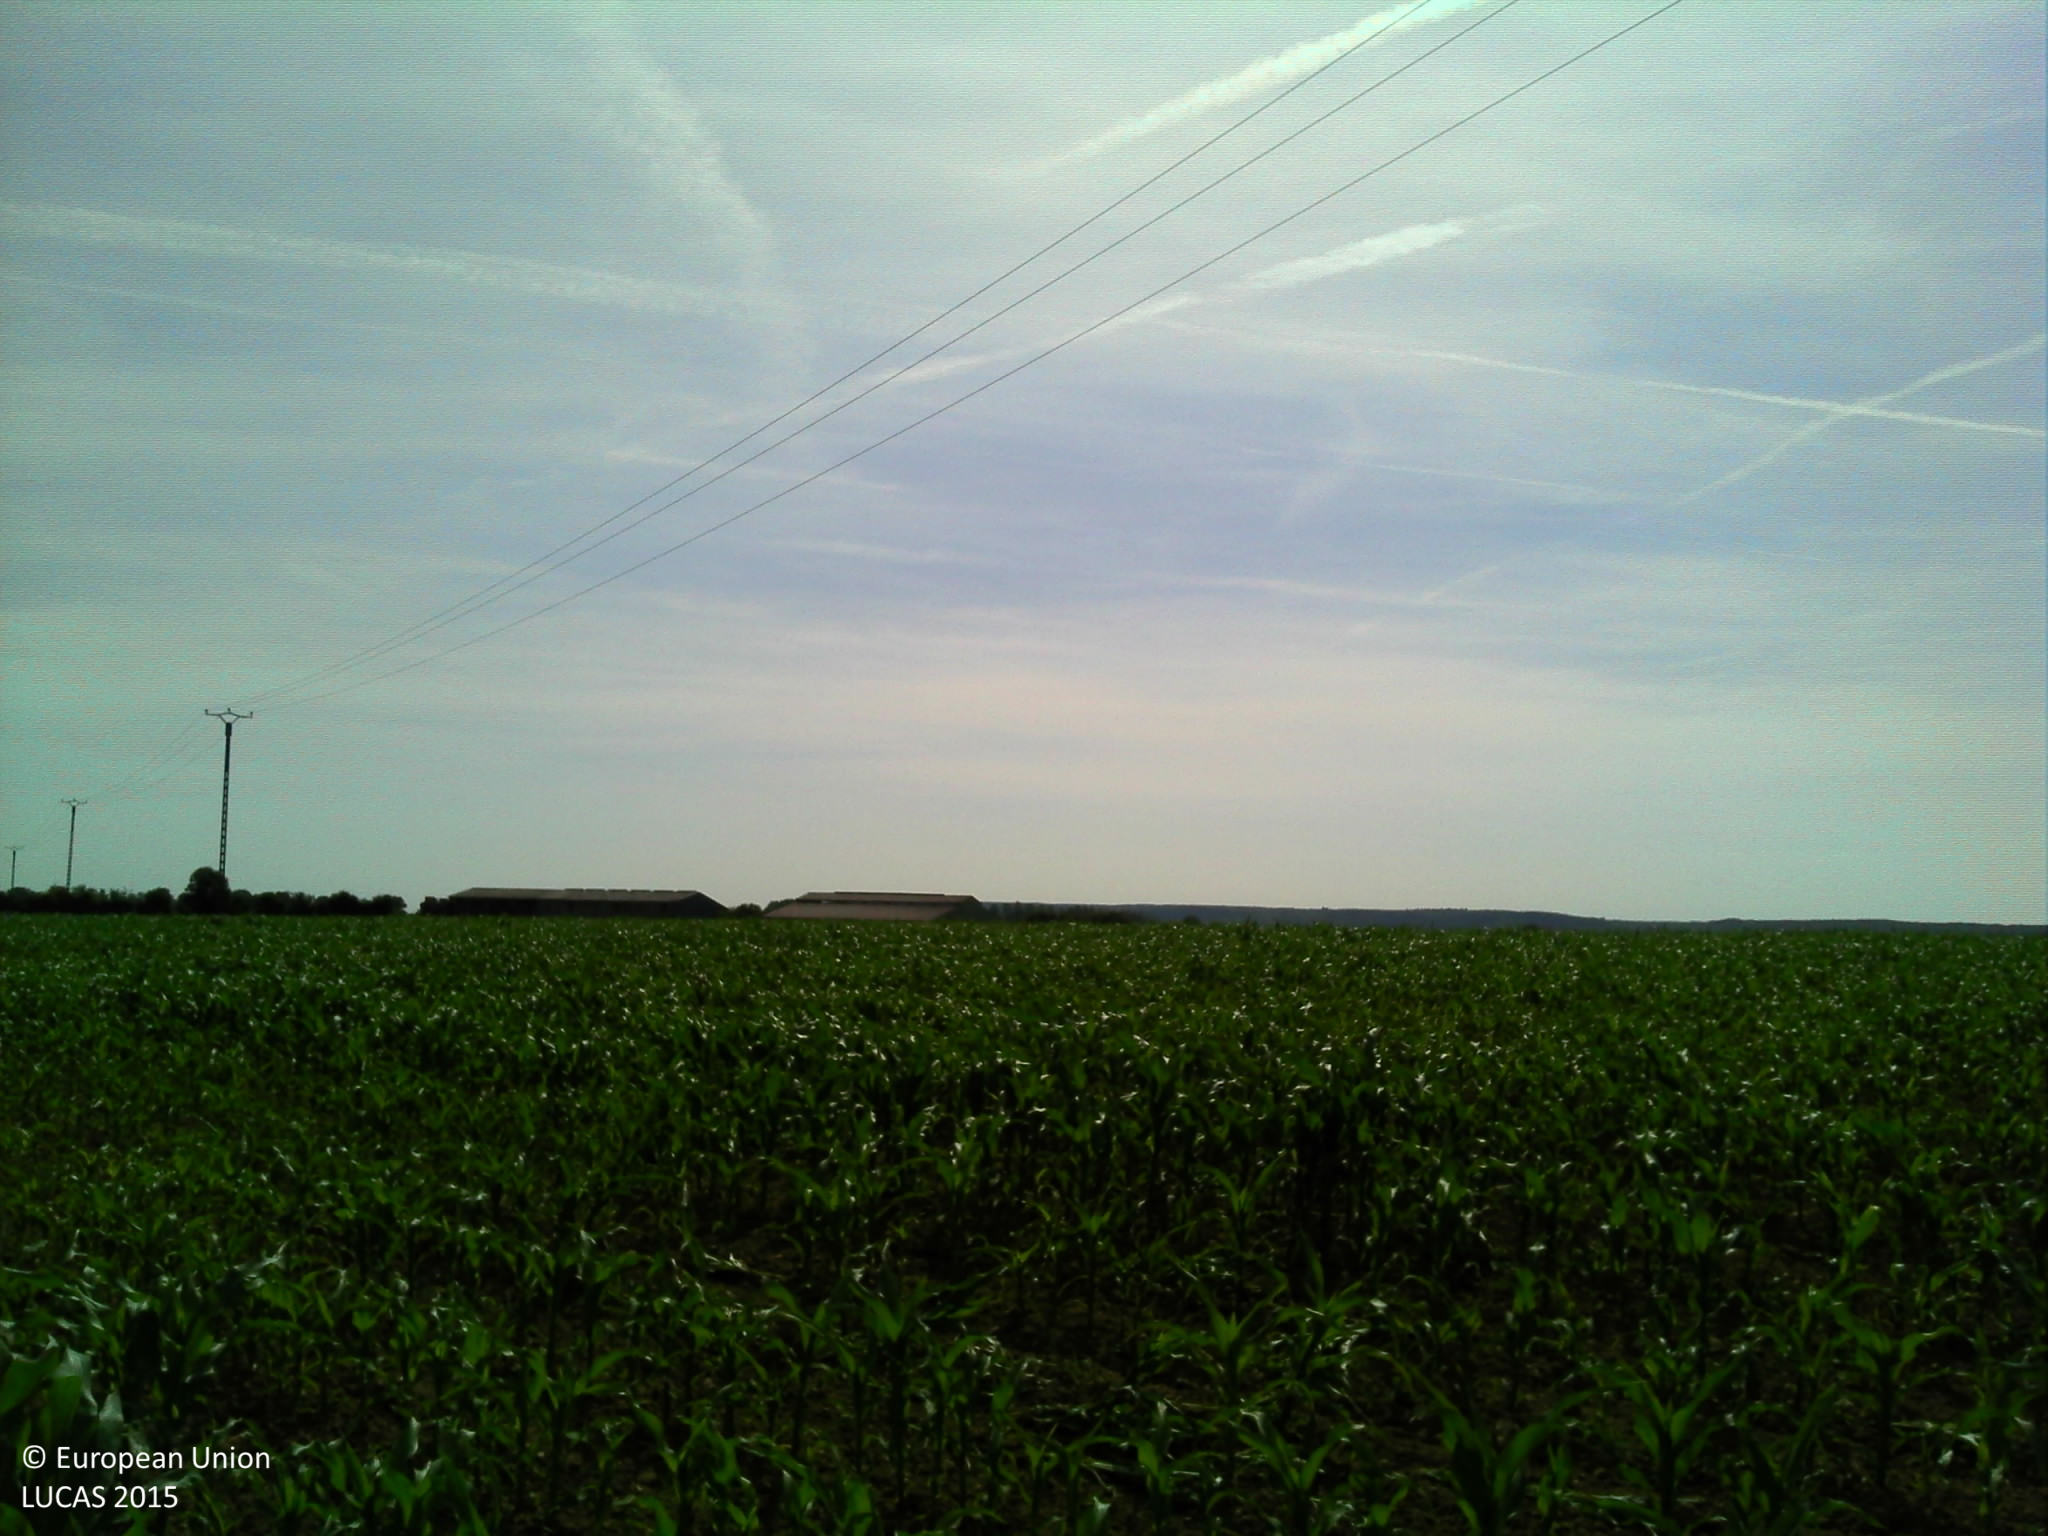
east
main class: Cropland
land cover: Maize
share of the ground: 25 - 50 %
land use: Agriculture (excluding fallow land and kitchen gardens)
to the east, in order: Maize; Electric lines; Maize; Abandoned hedges; Fences; Grassland without tree/shrub cover
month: June
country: FR
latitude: 48.4335
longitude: 0.1459
